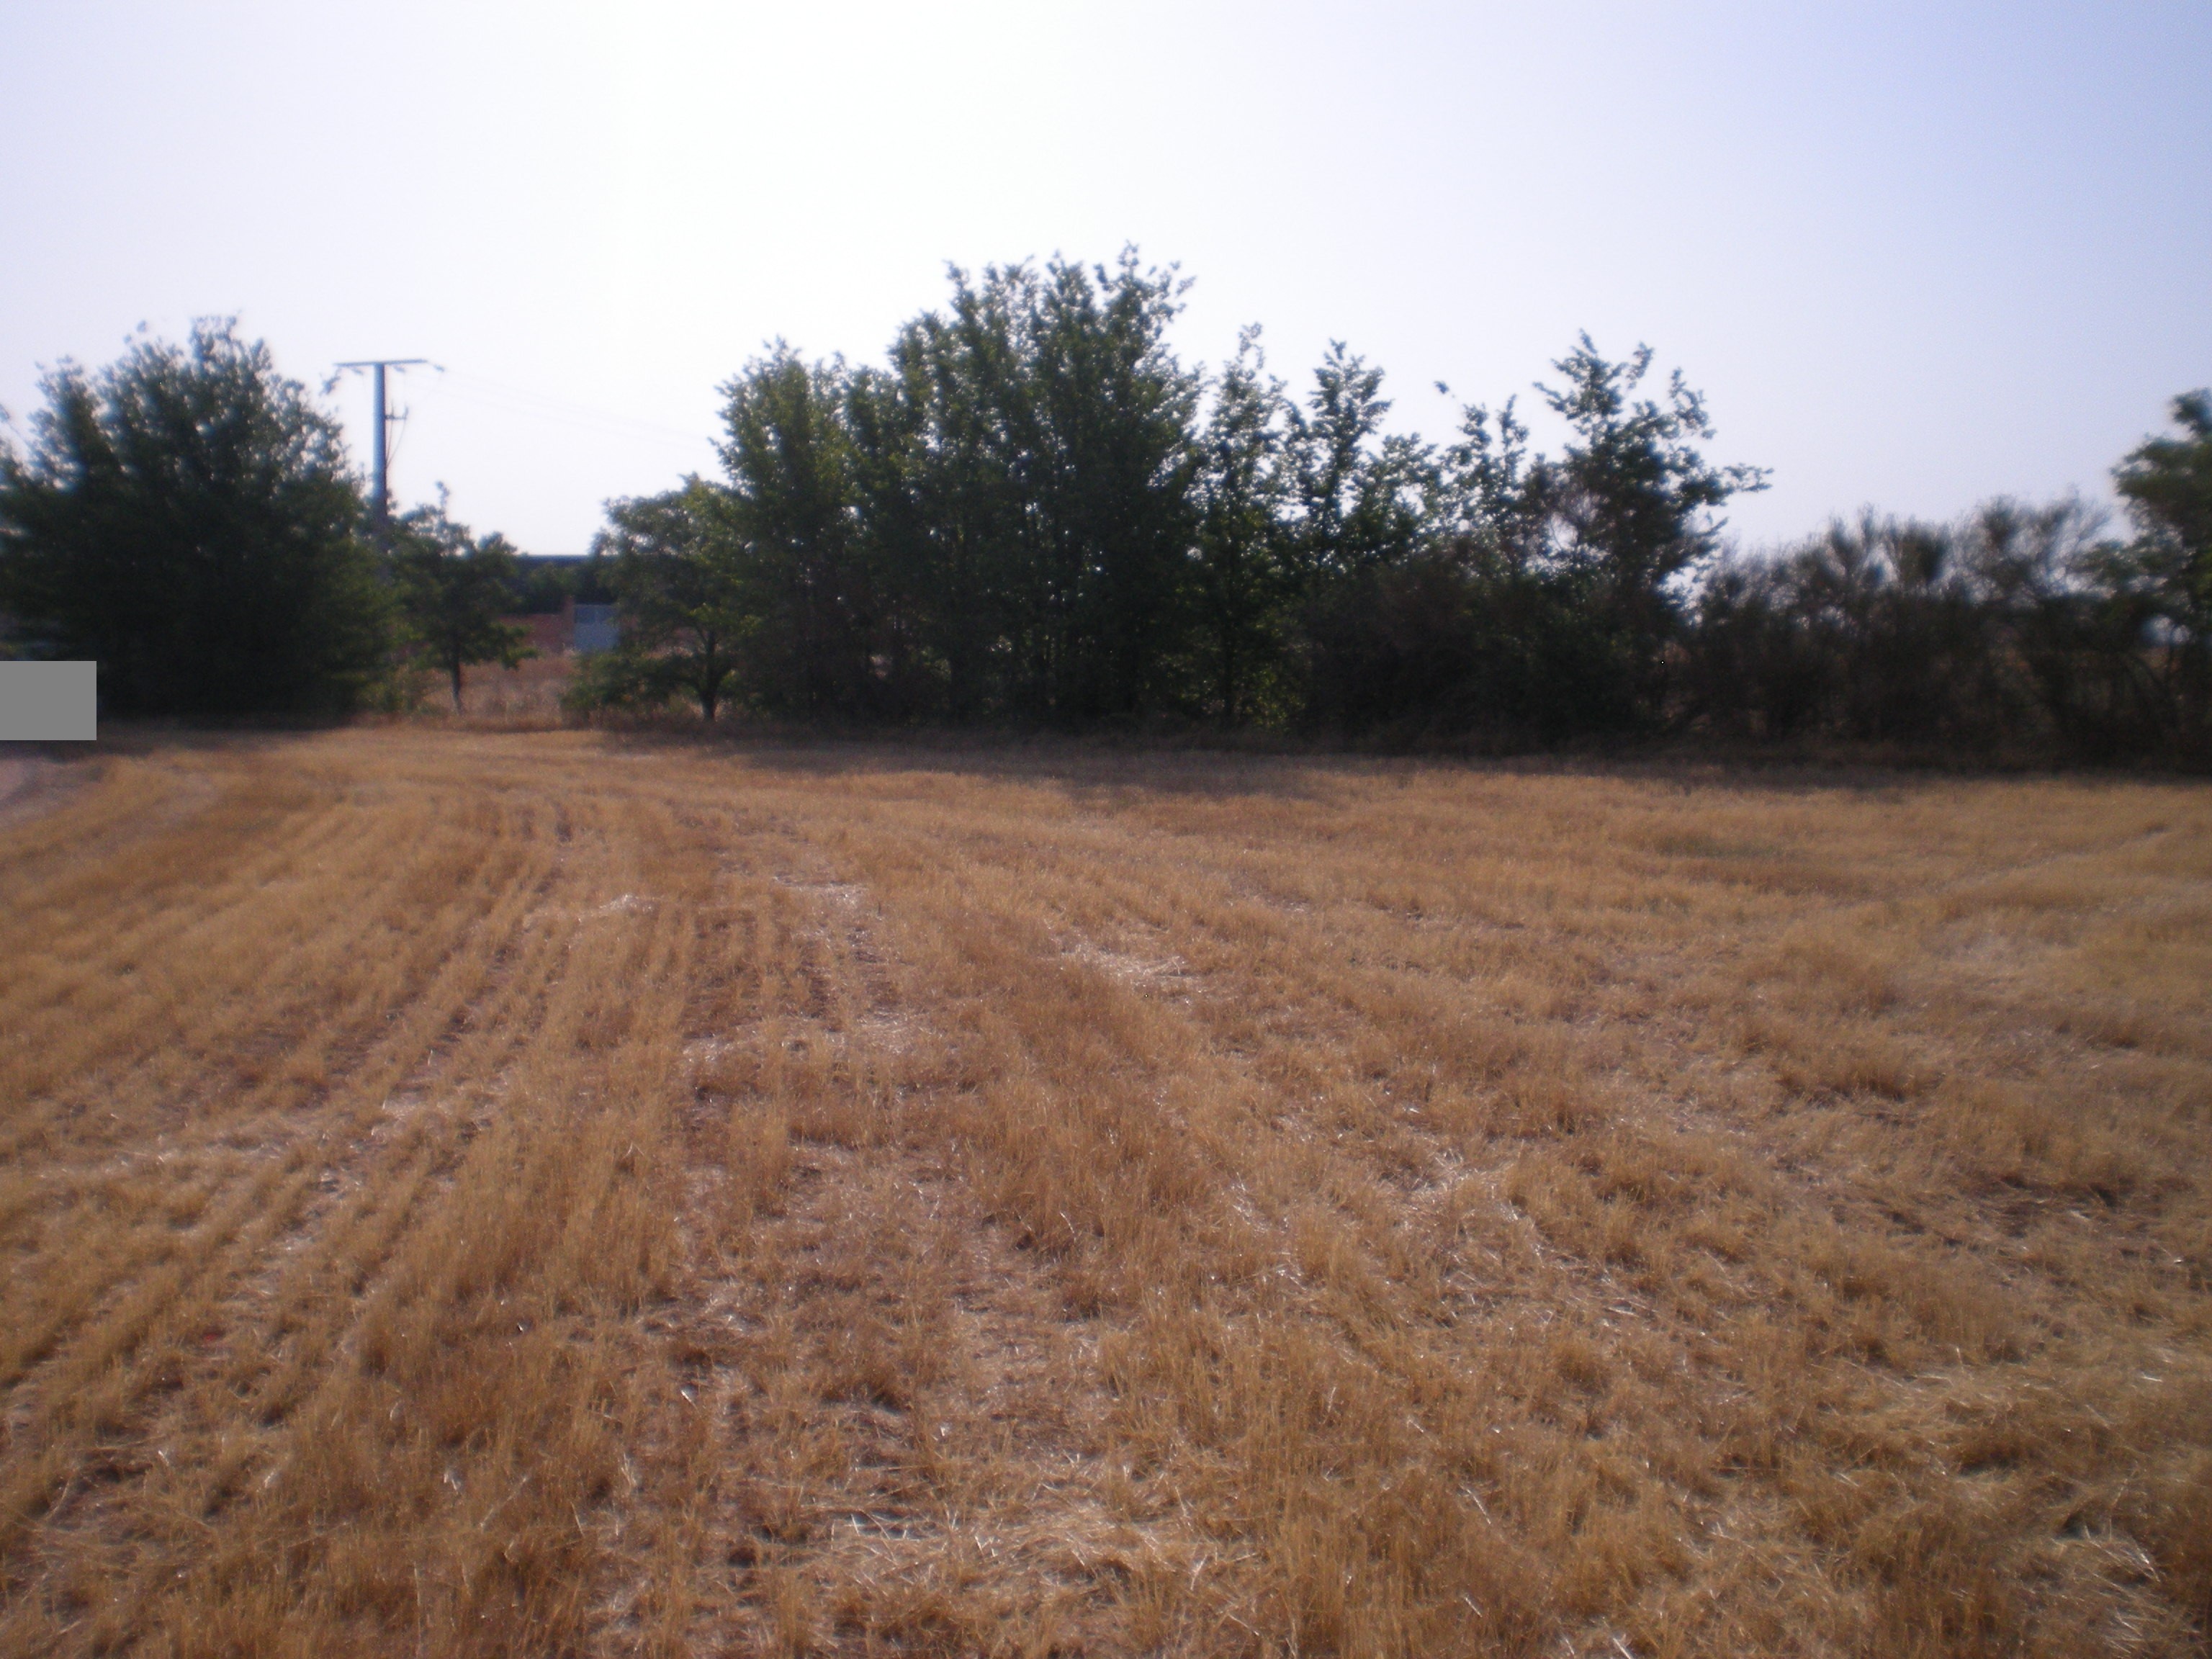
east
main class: Cropland
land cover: Barley
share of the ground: < 10 %
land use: Agriculture (excluding fallow land and kitchen gardens)
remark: Harvested field
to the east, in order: Barley; Abandoned hedges; Grass margins; Tracks; Grass margins; Abandoned hedges; Grassland without tree/shrub cover; Other bare soil; Electric lines; Other bare soil; Tracks; Dry stone walls; Grass margins; Other bare soil
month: July
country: ES
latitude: 39.4214
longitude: -3.3667
